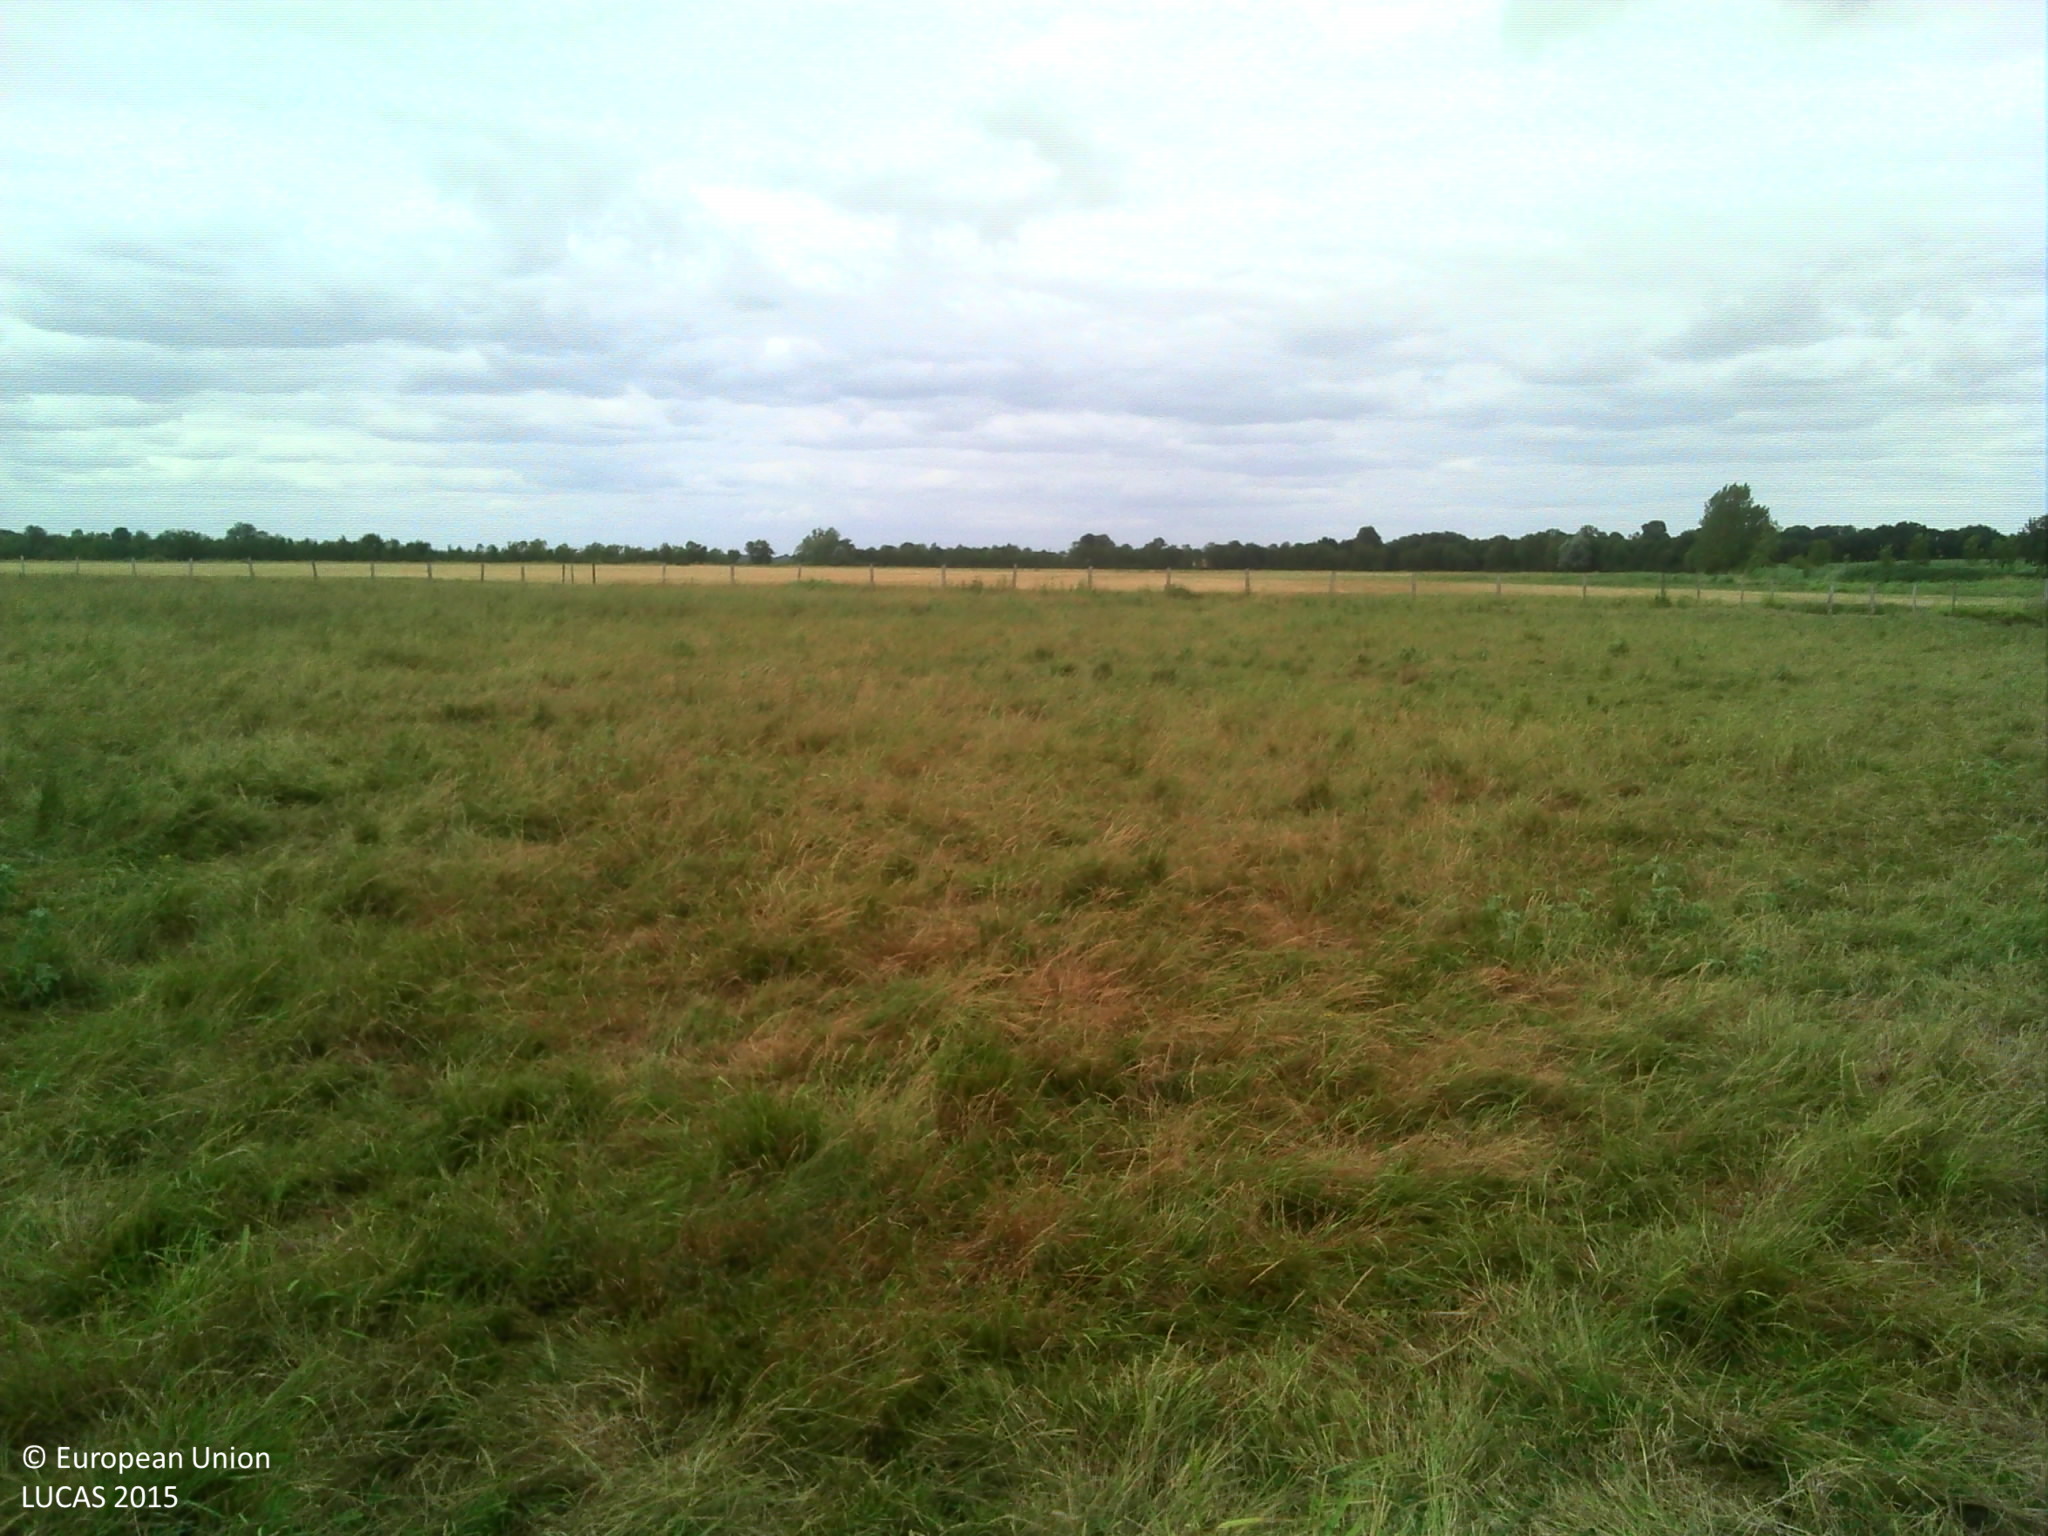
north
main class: Grassland
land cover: Grassland without tree/shrub cover
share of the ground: > 75 %
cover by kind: herbaceous plants 100 %
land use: Agriculture (excluding fallow land and kitchen gardens)
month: July
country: FR
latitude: 46.4240
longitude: -1.2904
